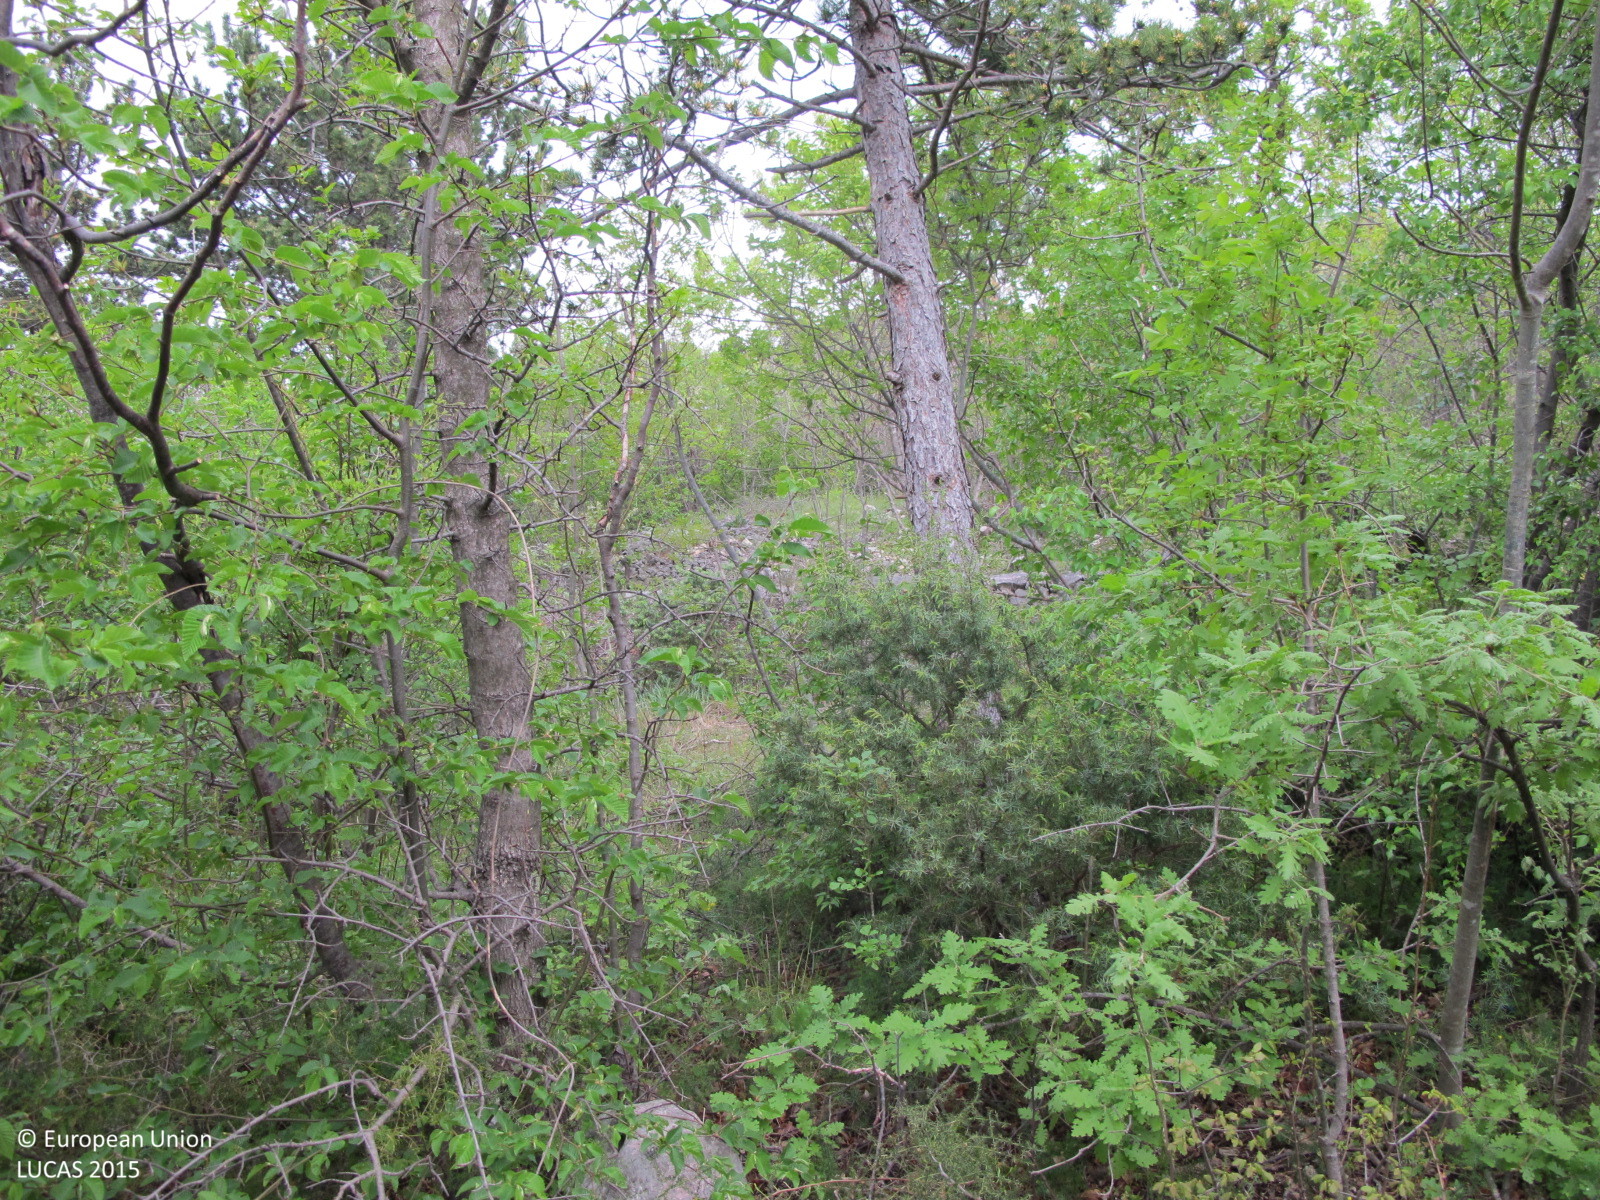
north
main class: Woodland
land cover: Broadleaved woodland
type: acidophilous oak and oak-birch forest
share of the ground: > 75 %
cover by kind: broadleaved forest trees 90 %, coniferous forest trees 5 %, shrubs 5 %
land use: Semi-natural and natural areas not in use
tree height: > 5 m
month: April
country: HR
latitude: 45.2027
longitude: 14.6669
